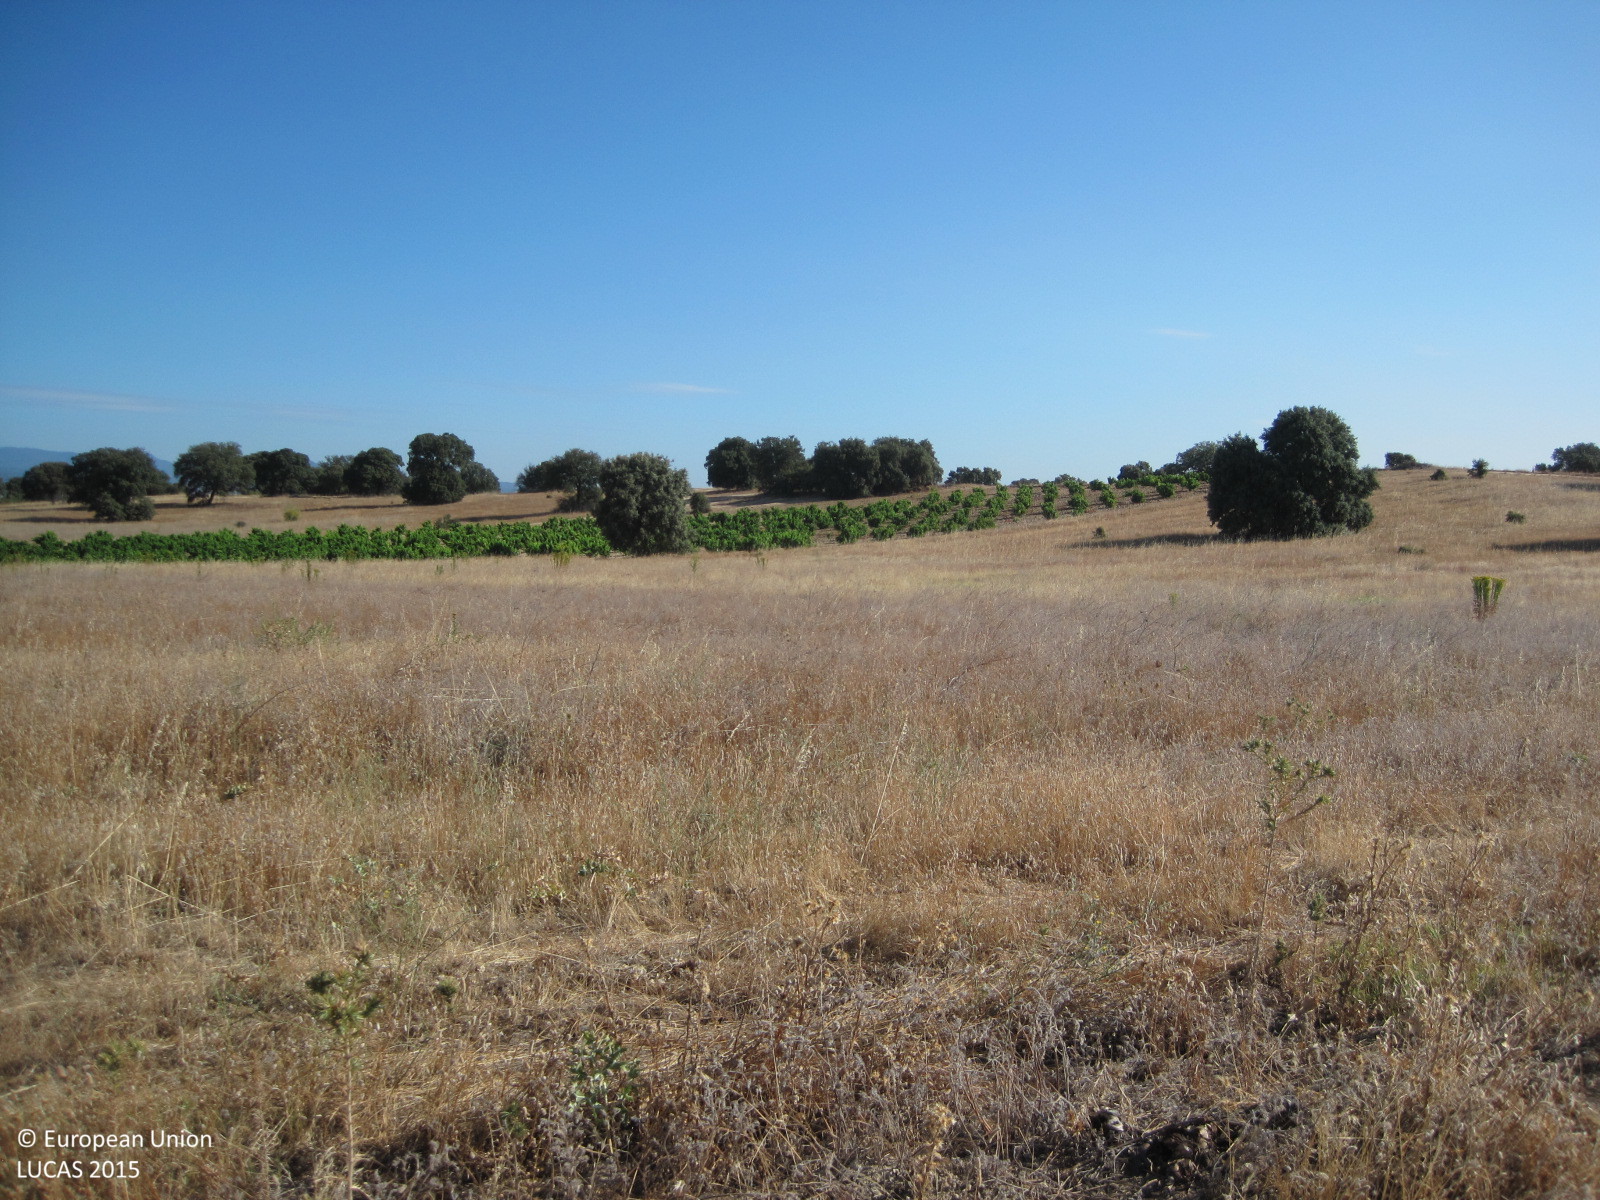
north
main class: Cropland
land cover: Vineyards
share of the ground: 25 - 50 %
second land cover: Other bare soil
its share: > 75 %
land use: Agriculture (excluding fallow land and kitchen gardens)
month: July
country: ES
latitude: 40.1382
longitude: -4.3741
